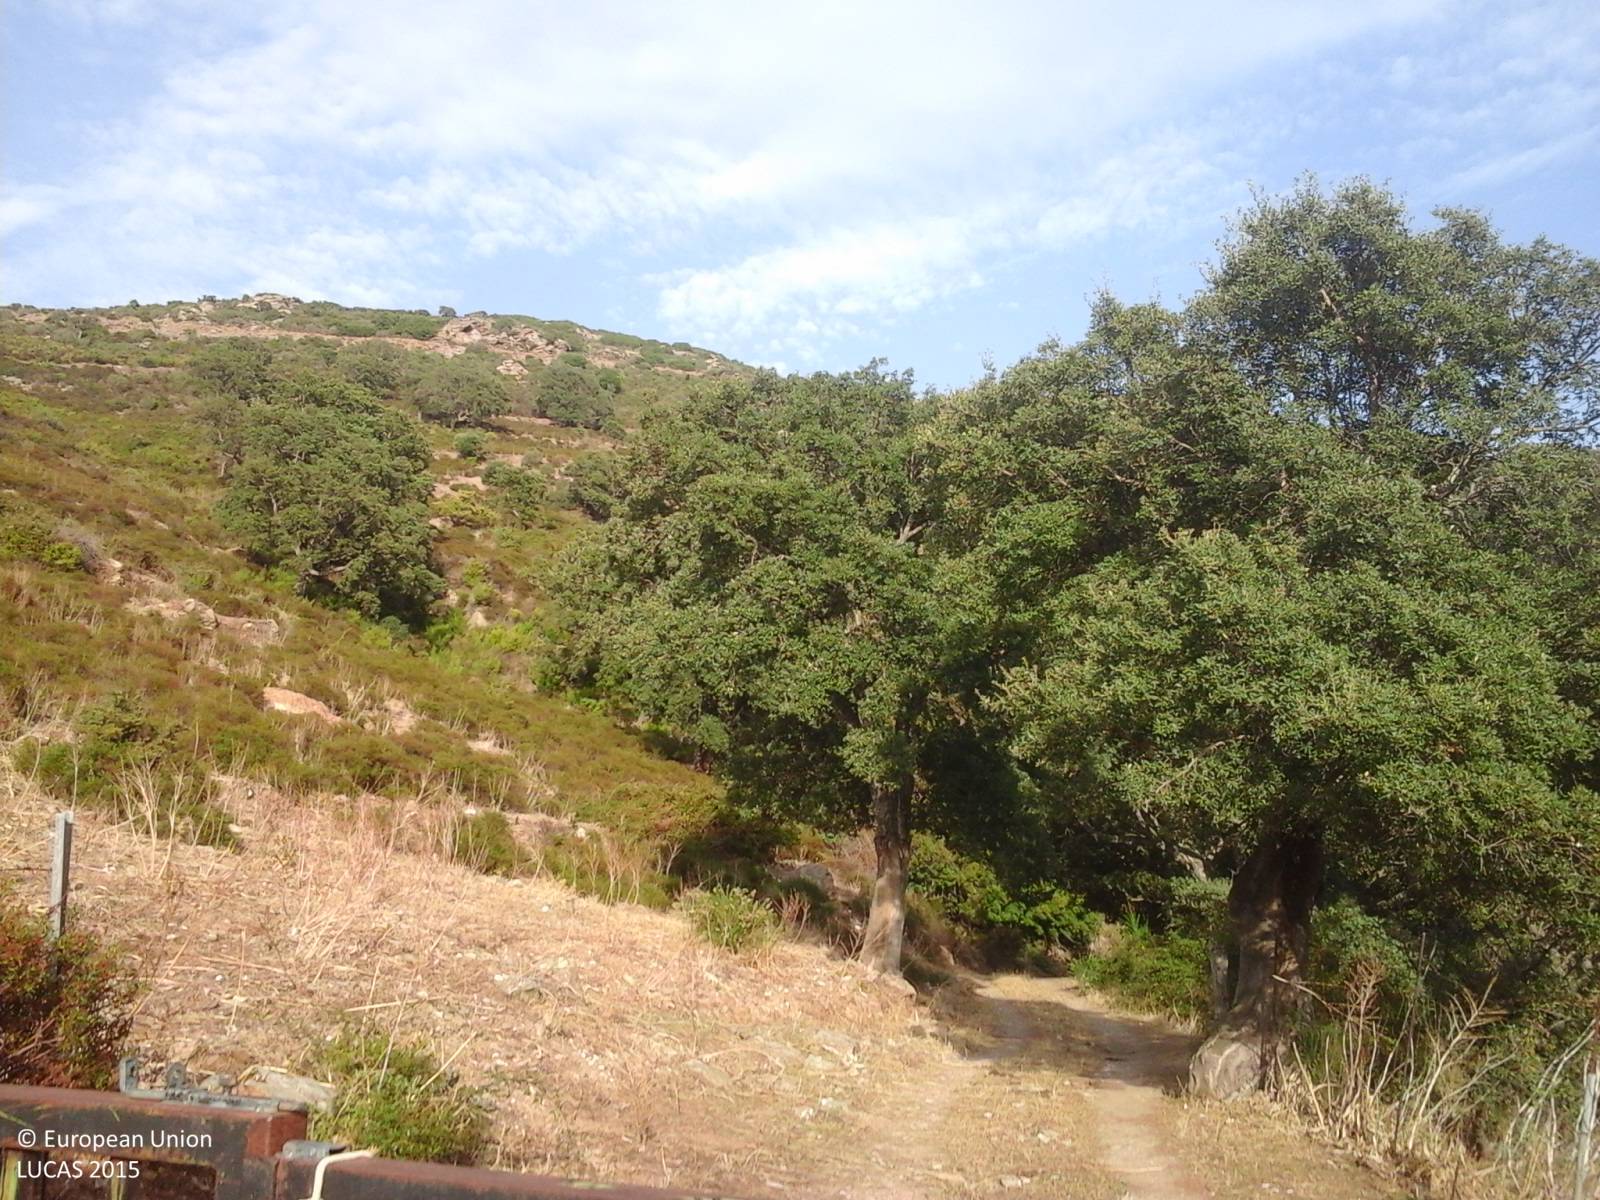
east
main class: Woodland
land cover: Broadleaved woodland
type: broadleaved evergreen forest
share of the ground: > 75 %
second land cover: Grassland without tree/shrub cover
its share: > 75 %
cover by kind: broadleaved forest trees 35 %, herbaceous plants 25 %, unconsolidated bare surface 20 %, shrubs 15 %, consolidated bare surface 5 %
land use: Agriculture (excluding fallow land and kitchen gardens)
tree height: > 5 m
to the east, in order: Broadleaved woodland; Grassland without tree/shrub cover; Abandoned hedges; Tracks; Grassland without tree/shrub cover; Broadleaved woodland; Shrubland without tree cover; Abandoned hedges; Tracks; Abandoned hedges; Shrubland without tree cover; Grassland with sparse tree/shrub cover
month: September
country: IT
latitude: 39.8316
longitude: 9.5236
